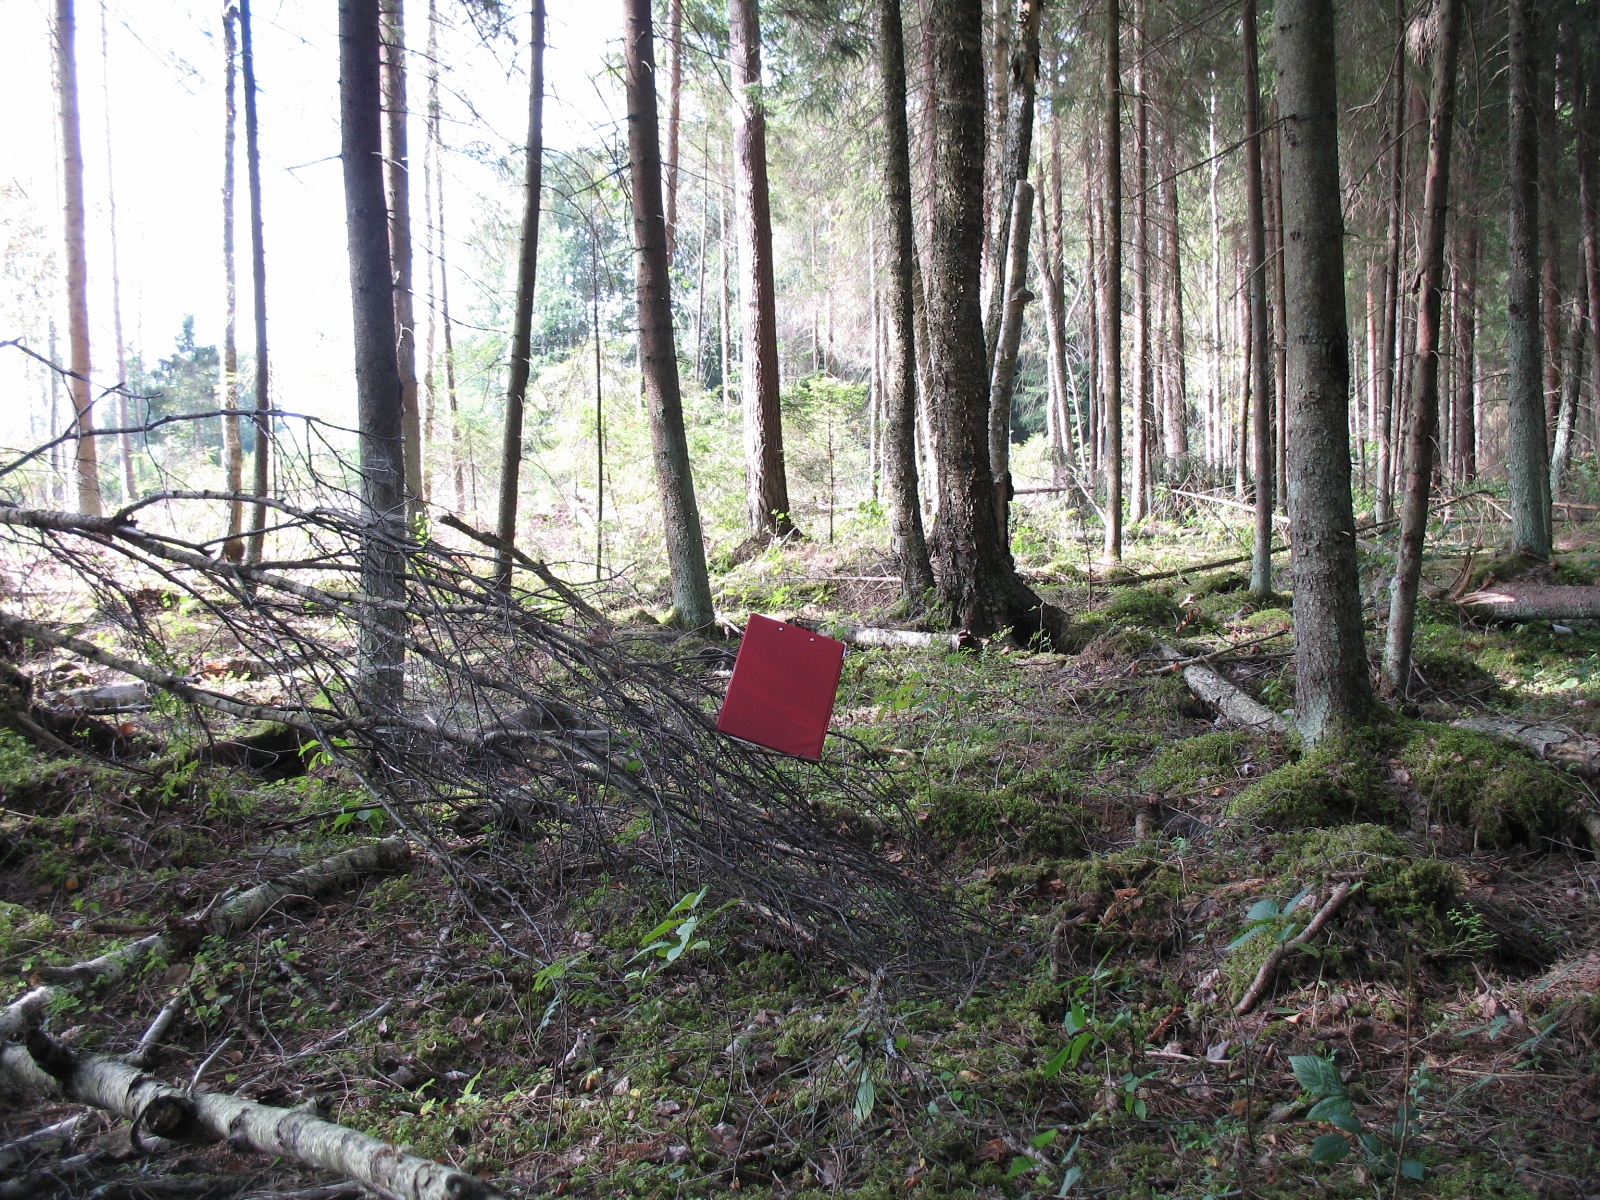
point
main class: Woodland
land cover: Other mixed woodland
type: hemiboreal forest and nemoral coniferous forest and mixed broadleaved-coniferous forest
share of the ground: > 75 %
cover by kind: coniferous forest trees 50 %, broadleaved forest trees 30 %, lichens and mosses 15 %, shrubs 5 %
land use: Forestry
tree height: > 5 m
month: August
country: LV
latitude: 56.4488
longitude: 25.6502
